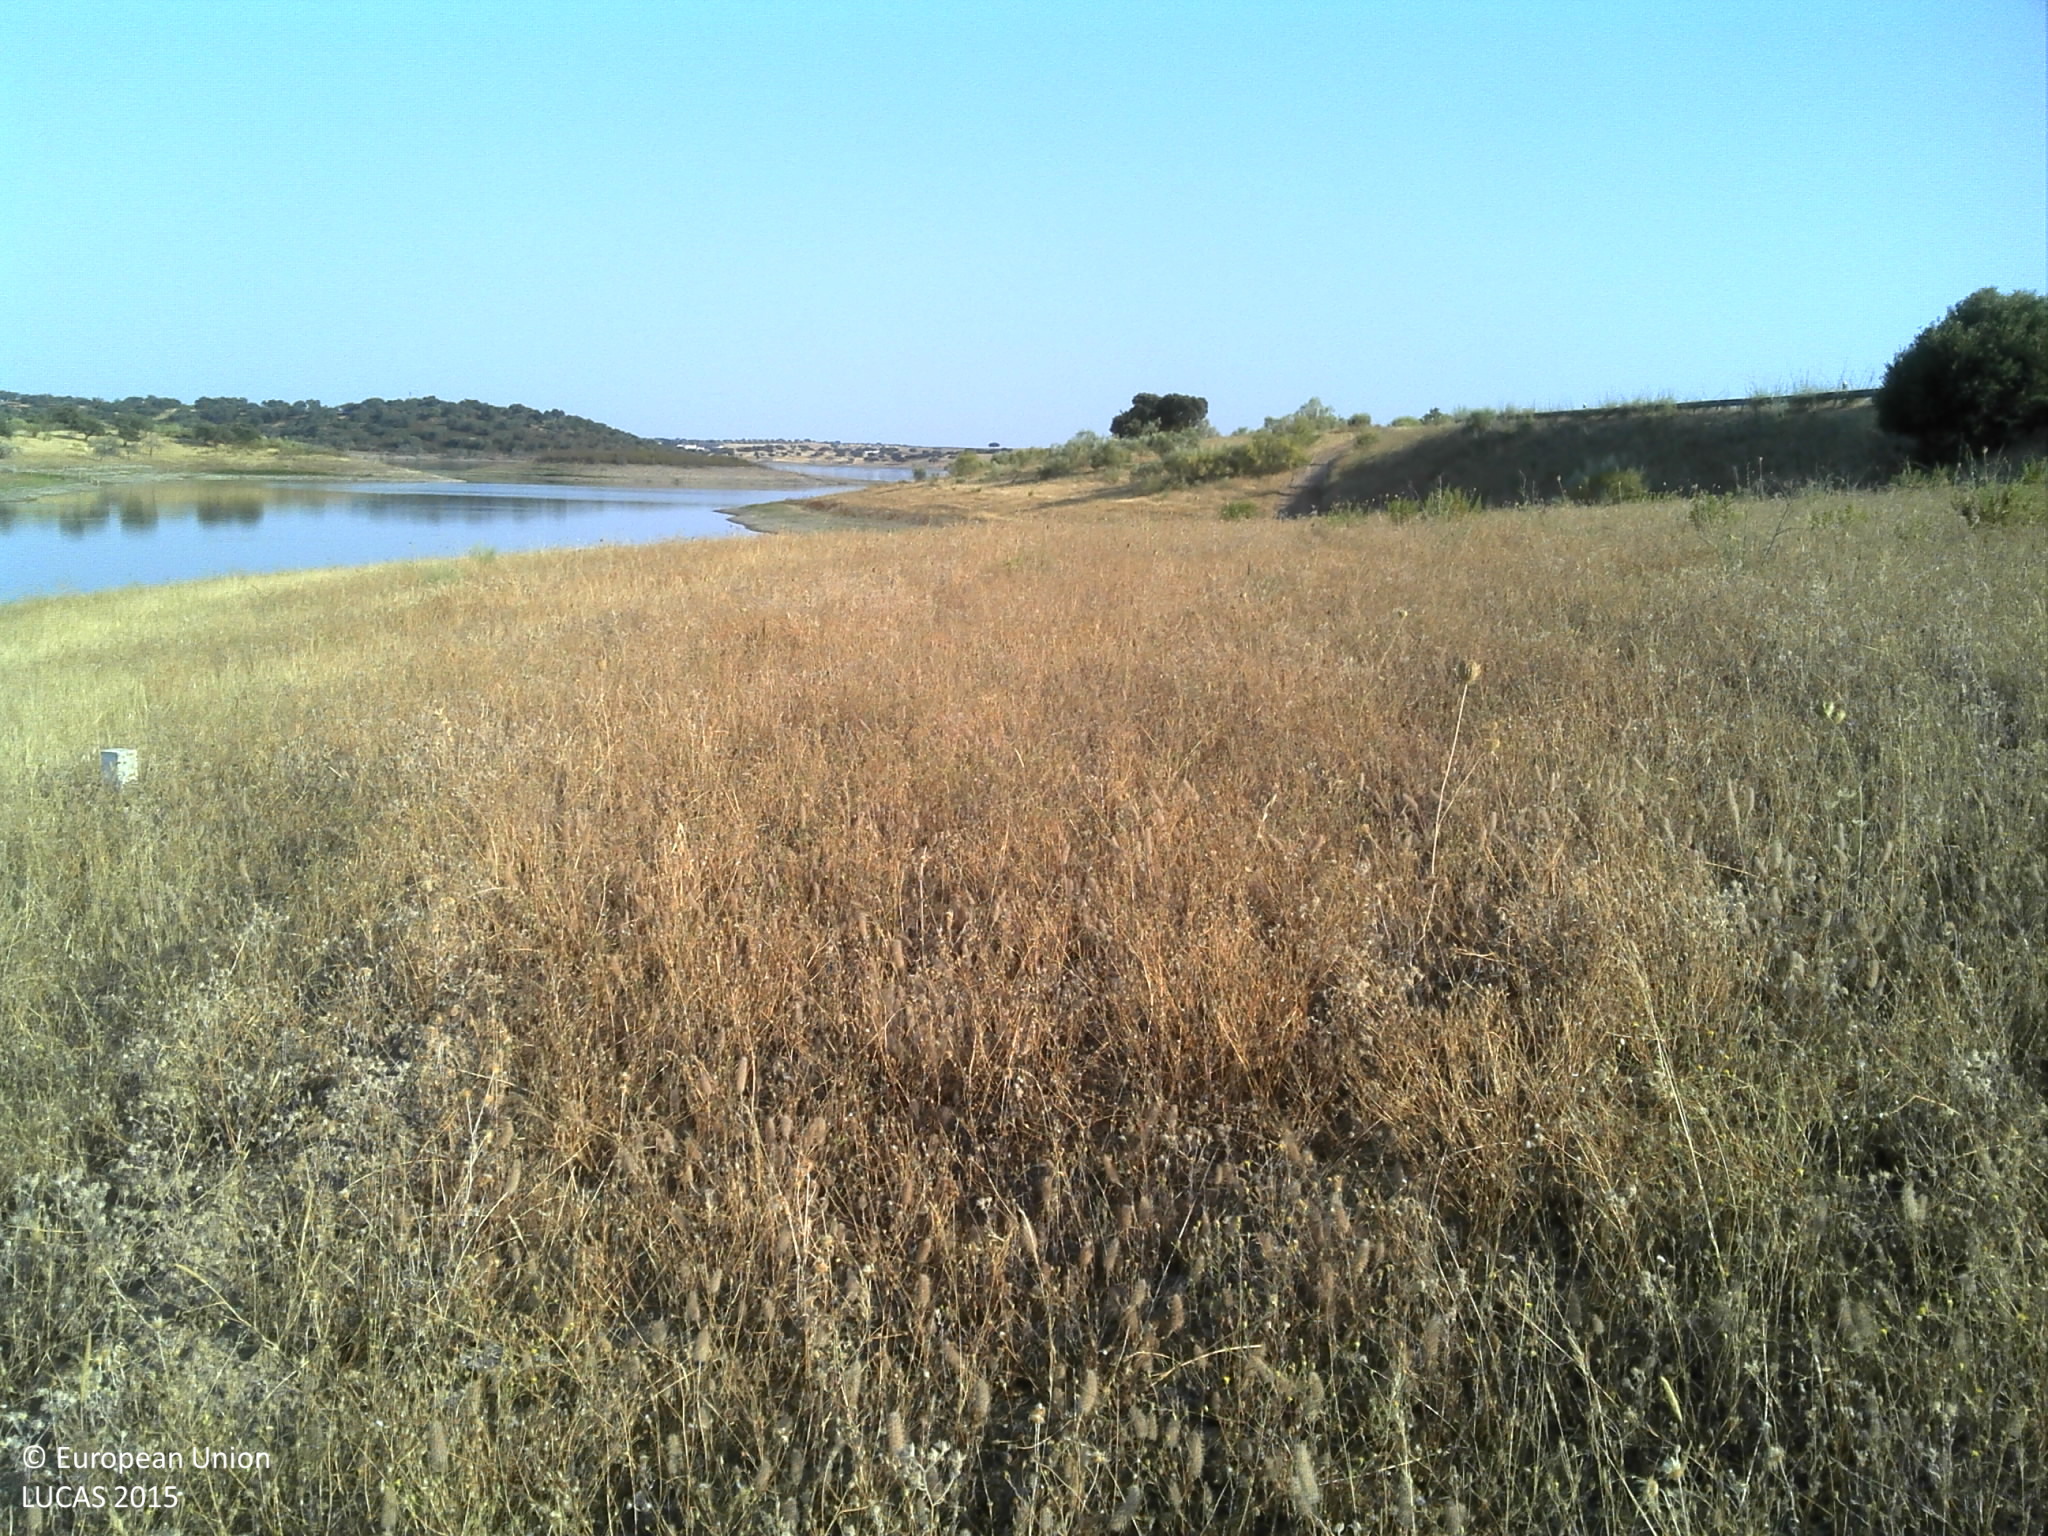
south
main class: Grassland
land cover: Grassland without tree/shrub cover
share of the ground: > 75 %
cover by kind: herbaceous plants 100 %
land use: Agriculture (excluding fallow land and kitchen gardens)
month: June
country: PT
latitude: 38.3244
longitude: -7.3281
